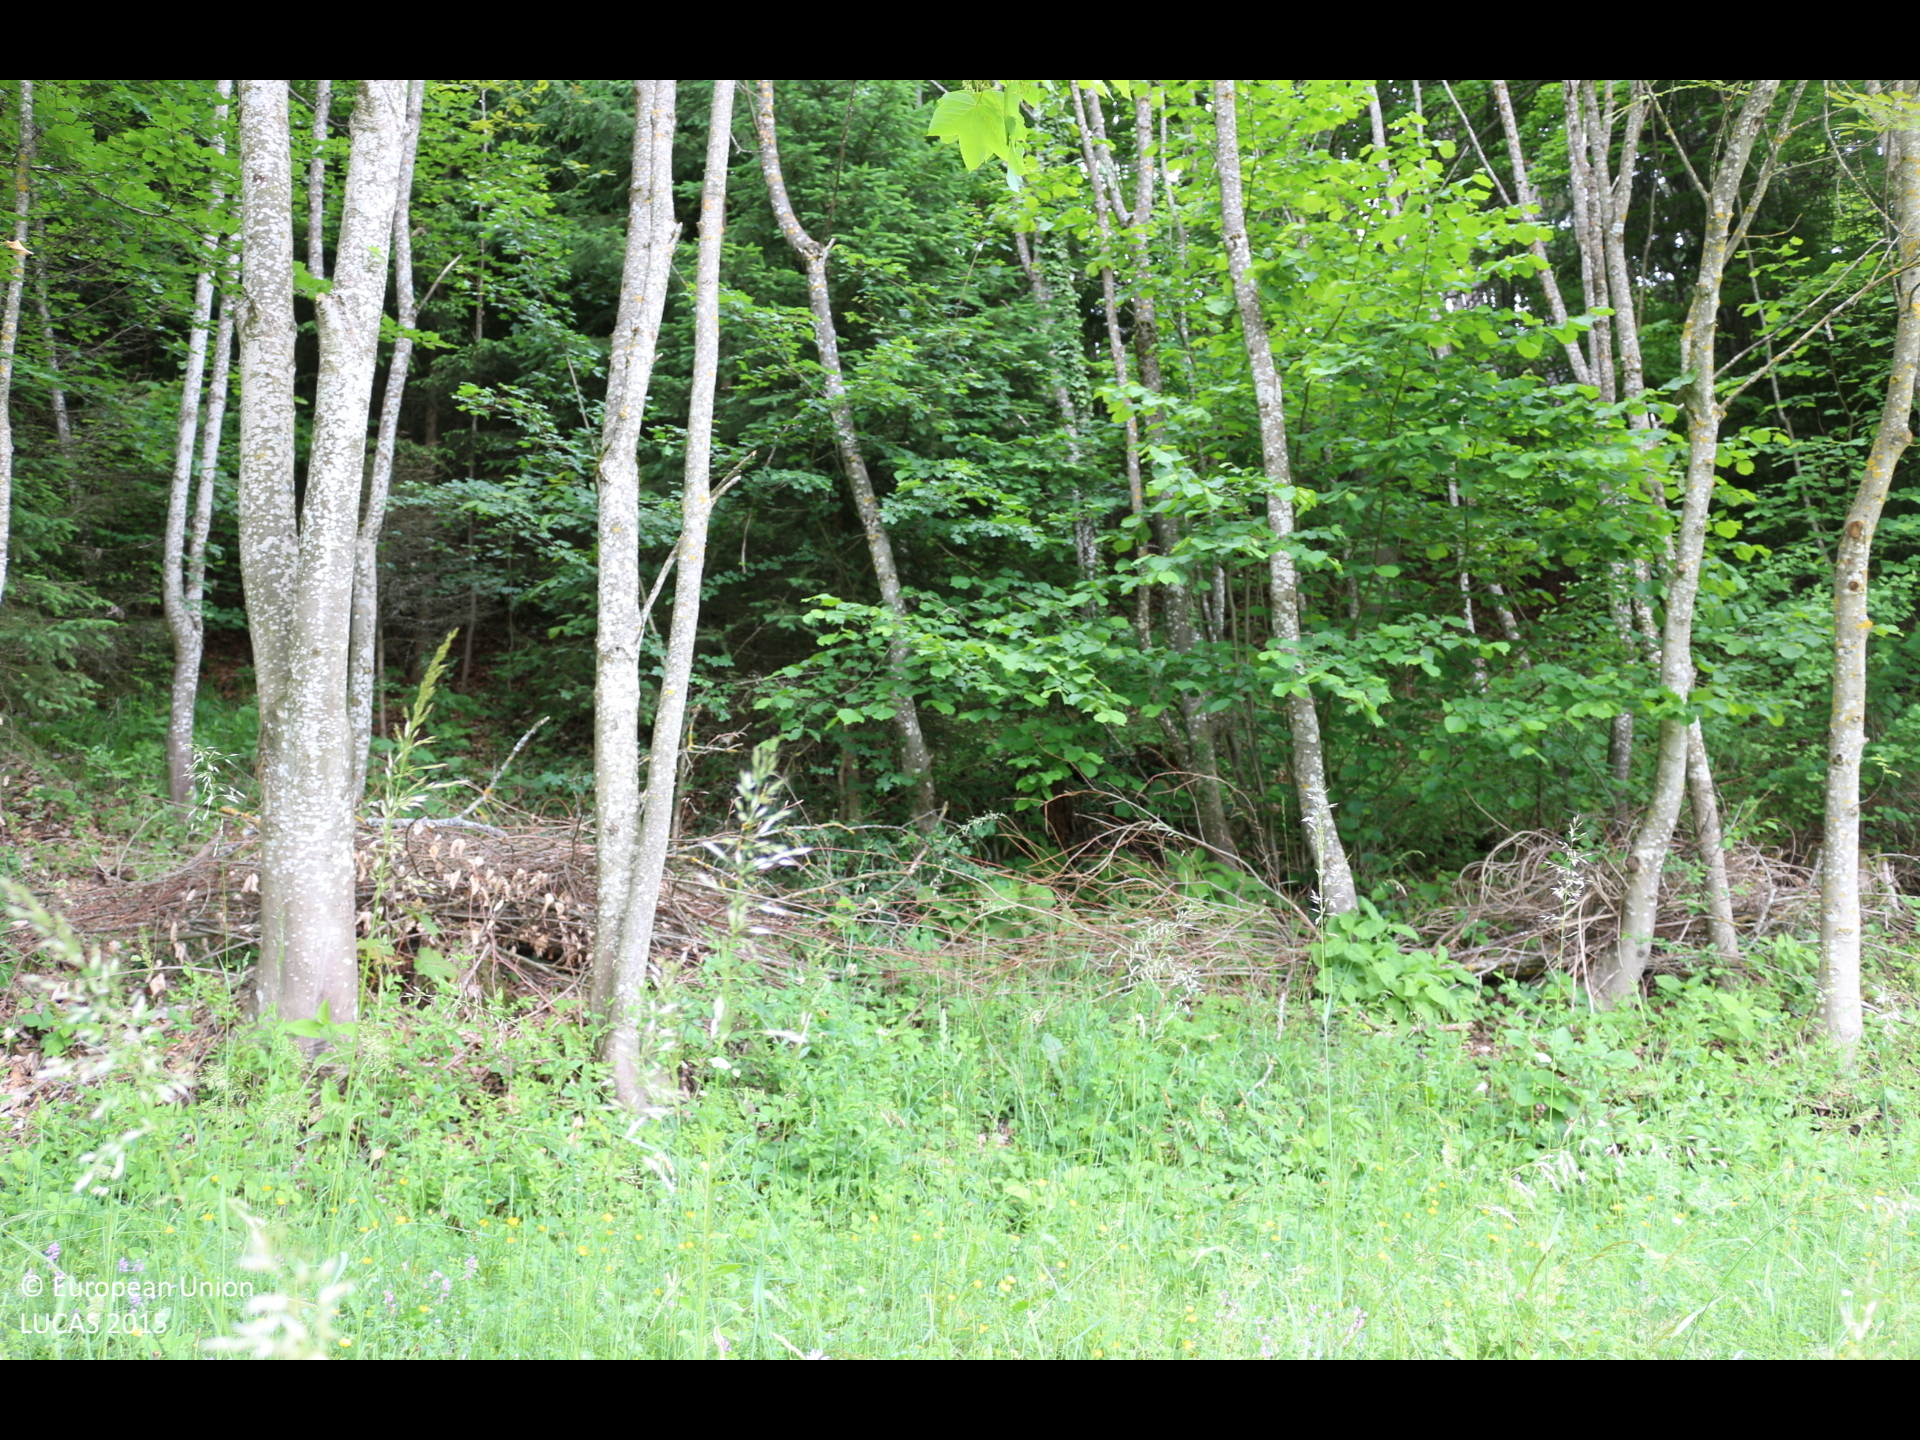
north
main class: Grassland
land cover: Grassland with sparse tree/shrub cover
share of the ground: > 75 %
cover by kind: herbaceous plants 90 %, broadleaved forest trees 5 %, shrubs 5 %
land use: Agriculture (excluding fallow land and kitchen gardens)
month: May
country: AT
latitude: 46.6992
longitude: 14.6930
